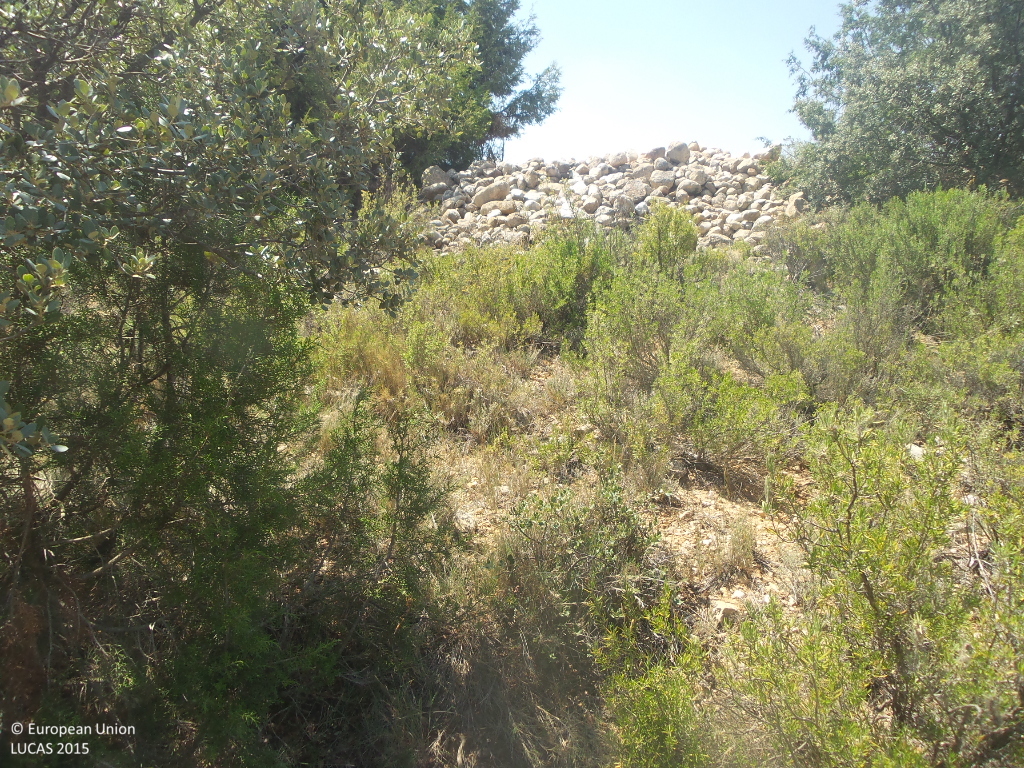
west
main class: Woodland
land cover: Broadleaved woodland
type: broadleaved evergreen forest
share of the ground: 25 - 50 %
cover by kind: broadleaved forest trees 40 %, shrubs 35 %, unconsolidated bare surface 15 %, coniferous forest trees 5 %, herbaceous plants 5 %
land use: Semi-natural and natural areas not in use
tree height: < 5 m
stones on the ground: < 10 %
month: July
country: ES
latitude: 41.1892
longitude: -2.1538
